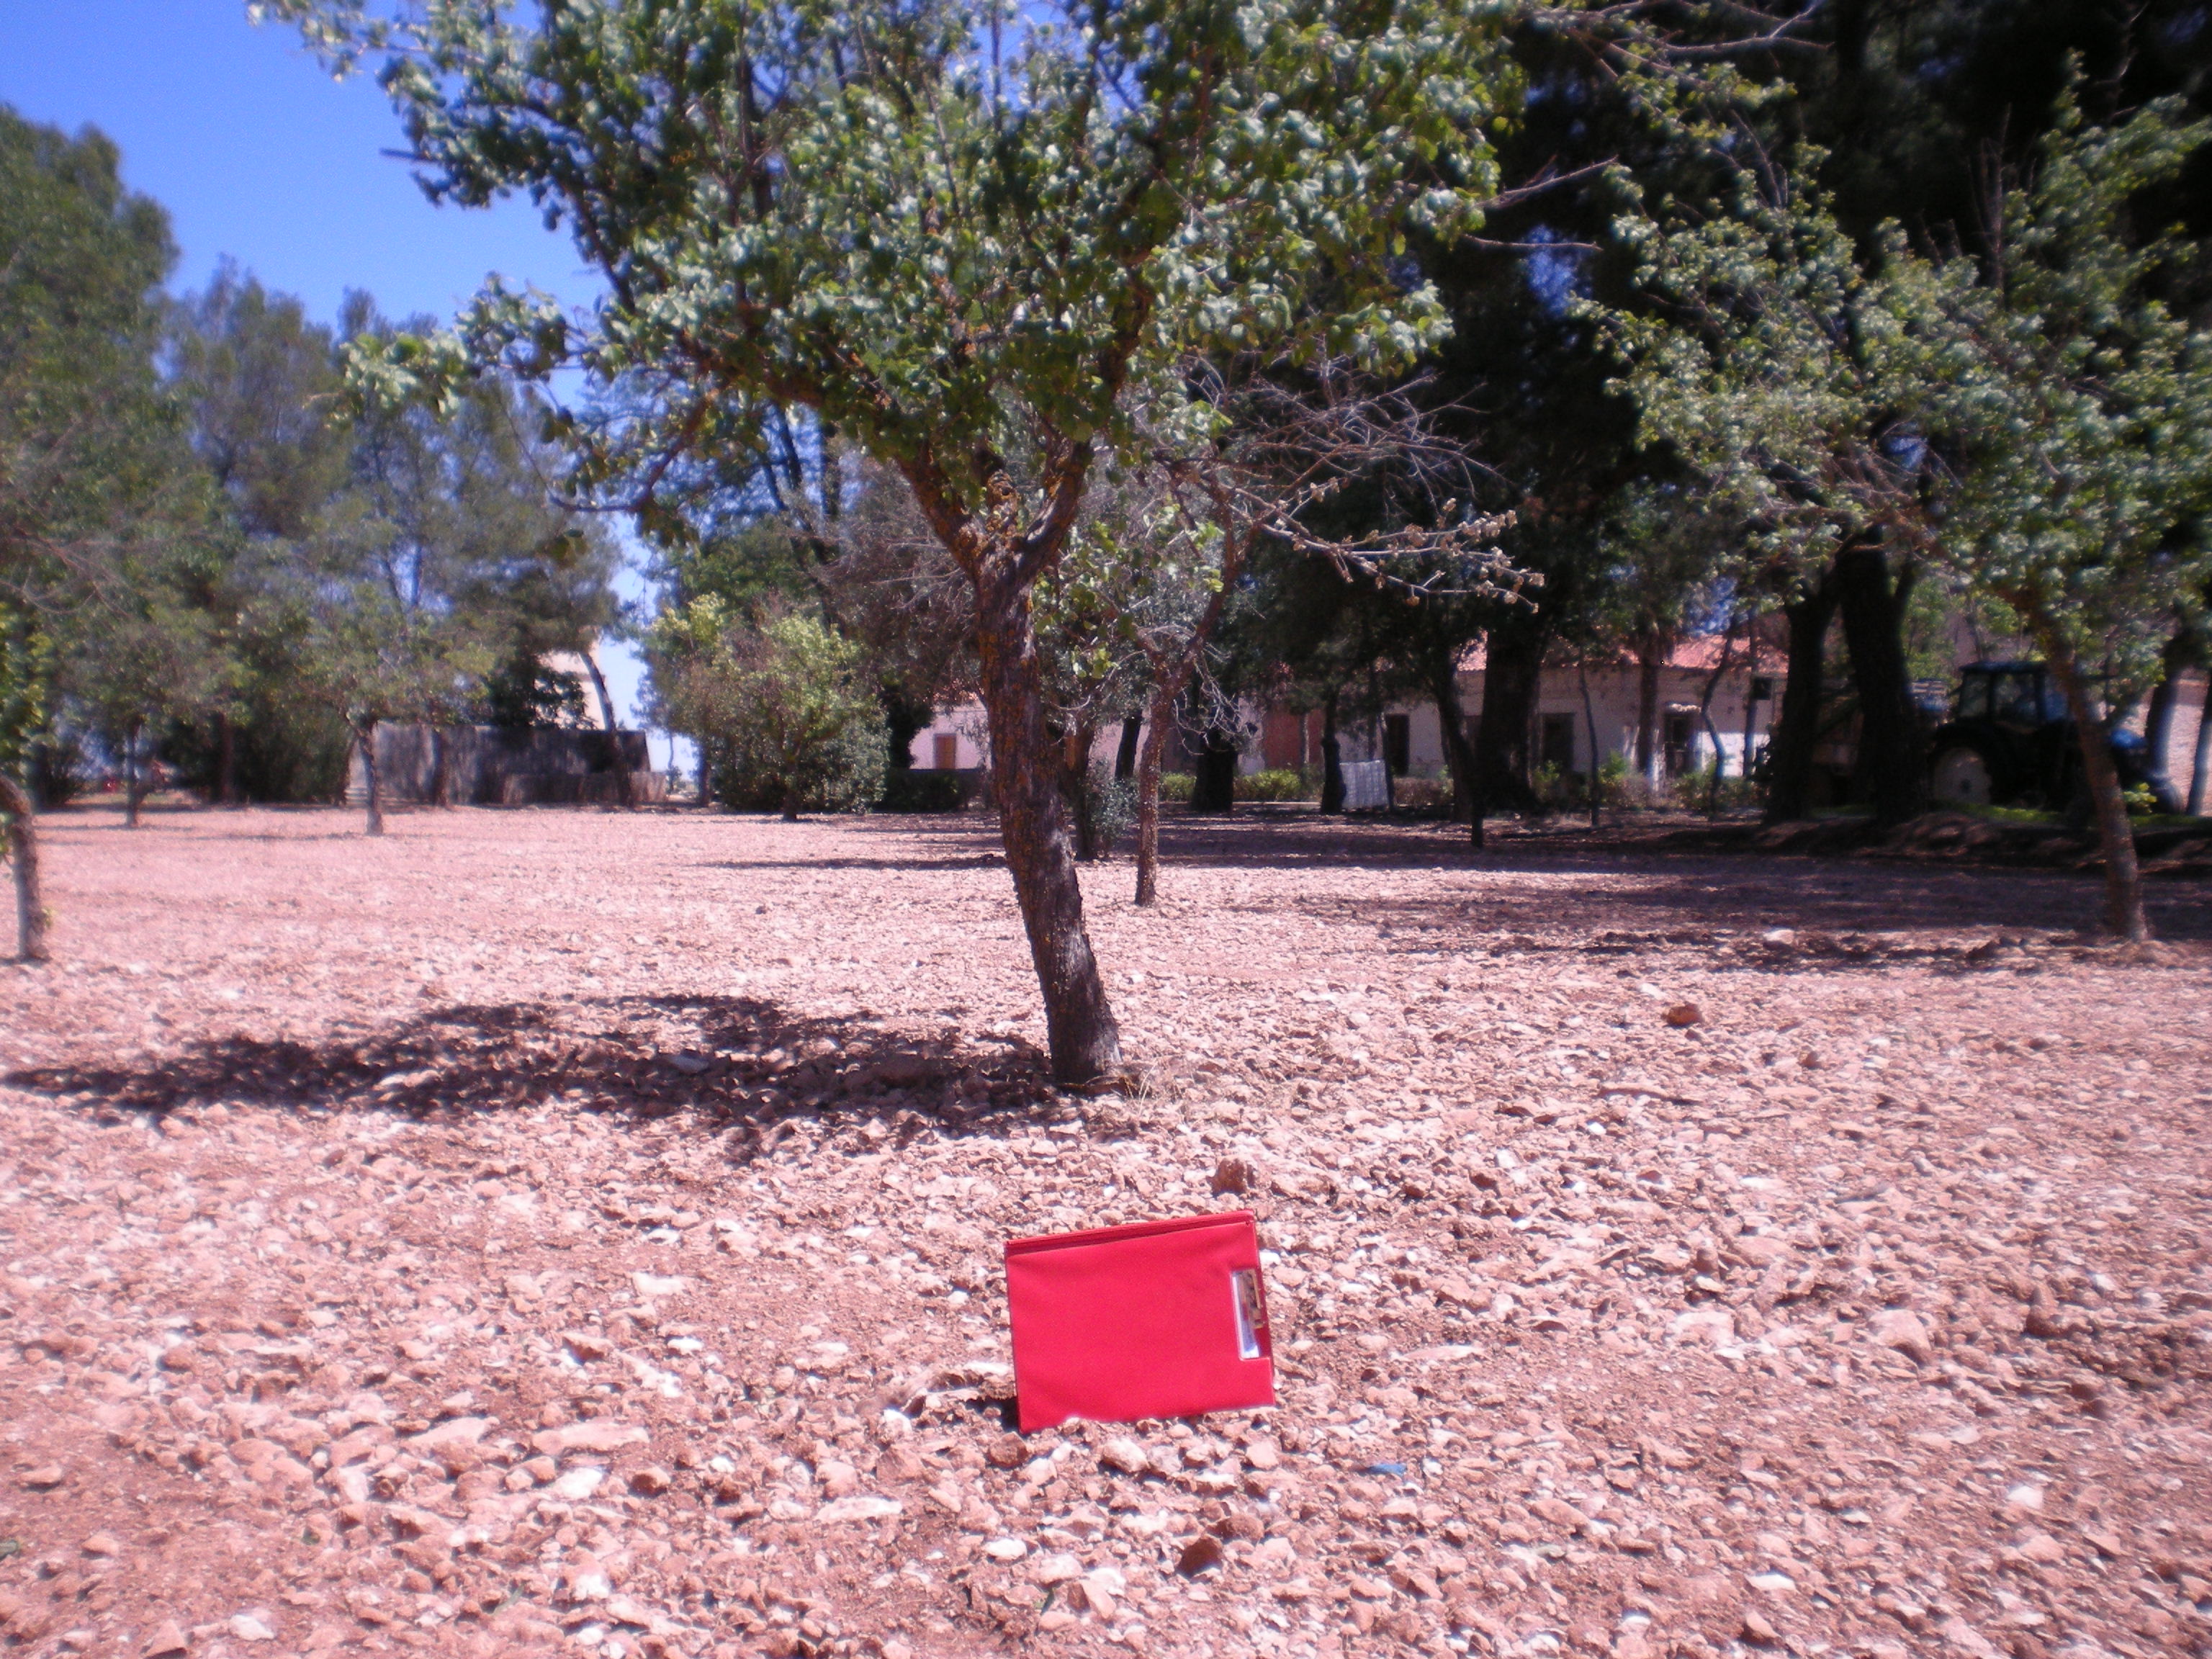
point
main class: Cropland
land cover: Other fruit trees and berries
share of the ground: < 10 %
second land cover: Other bare soil
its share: > 75 %
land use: Kitchen garden
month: May
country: ES
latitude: 39.1365
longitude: -3.3082
